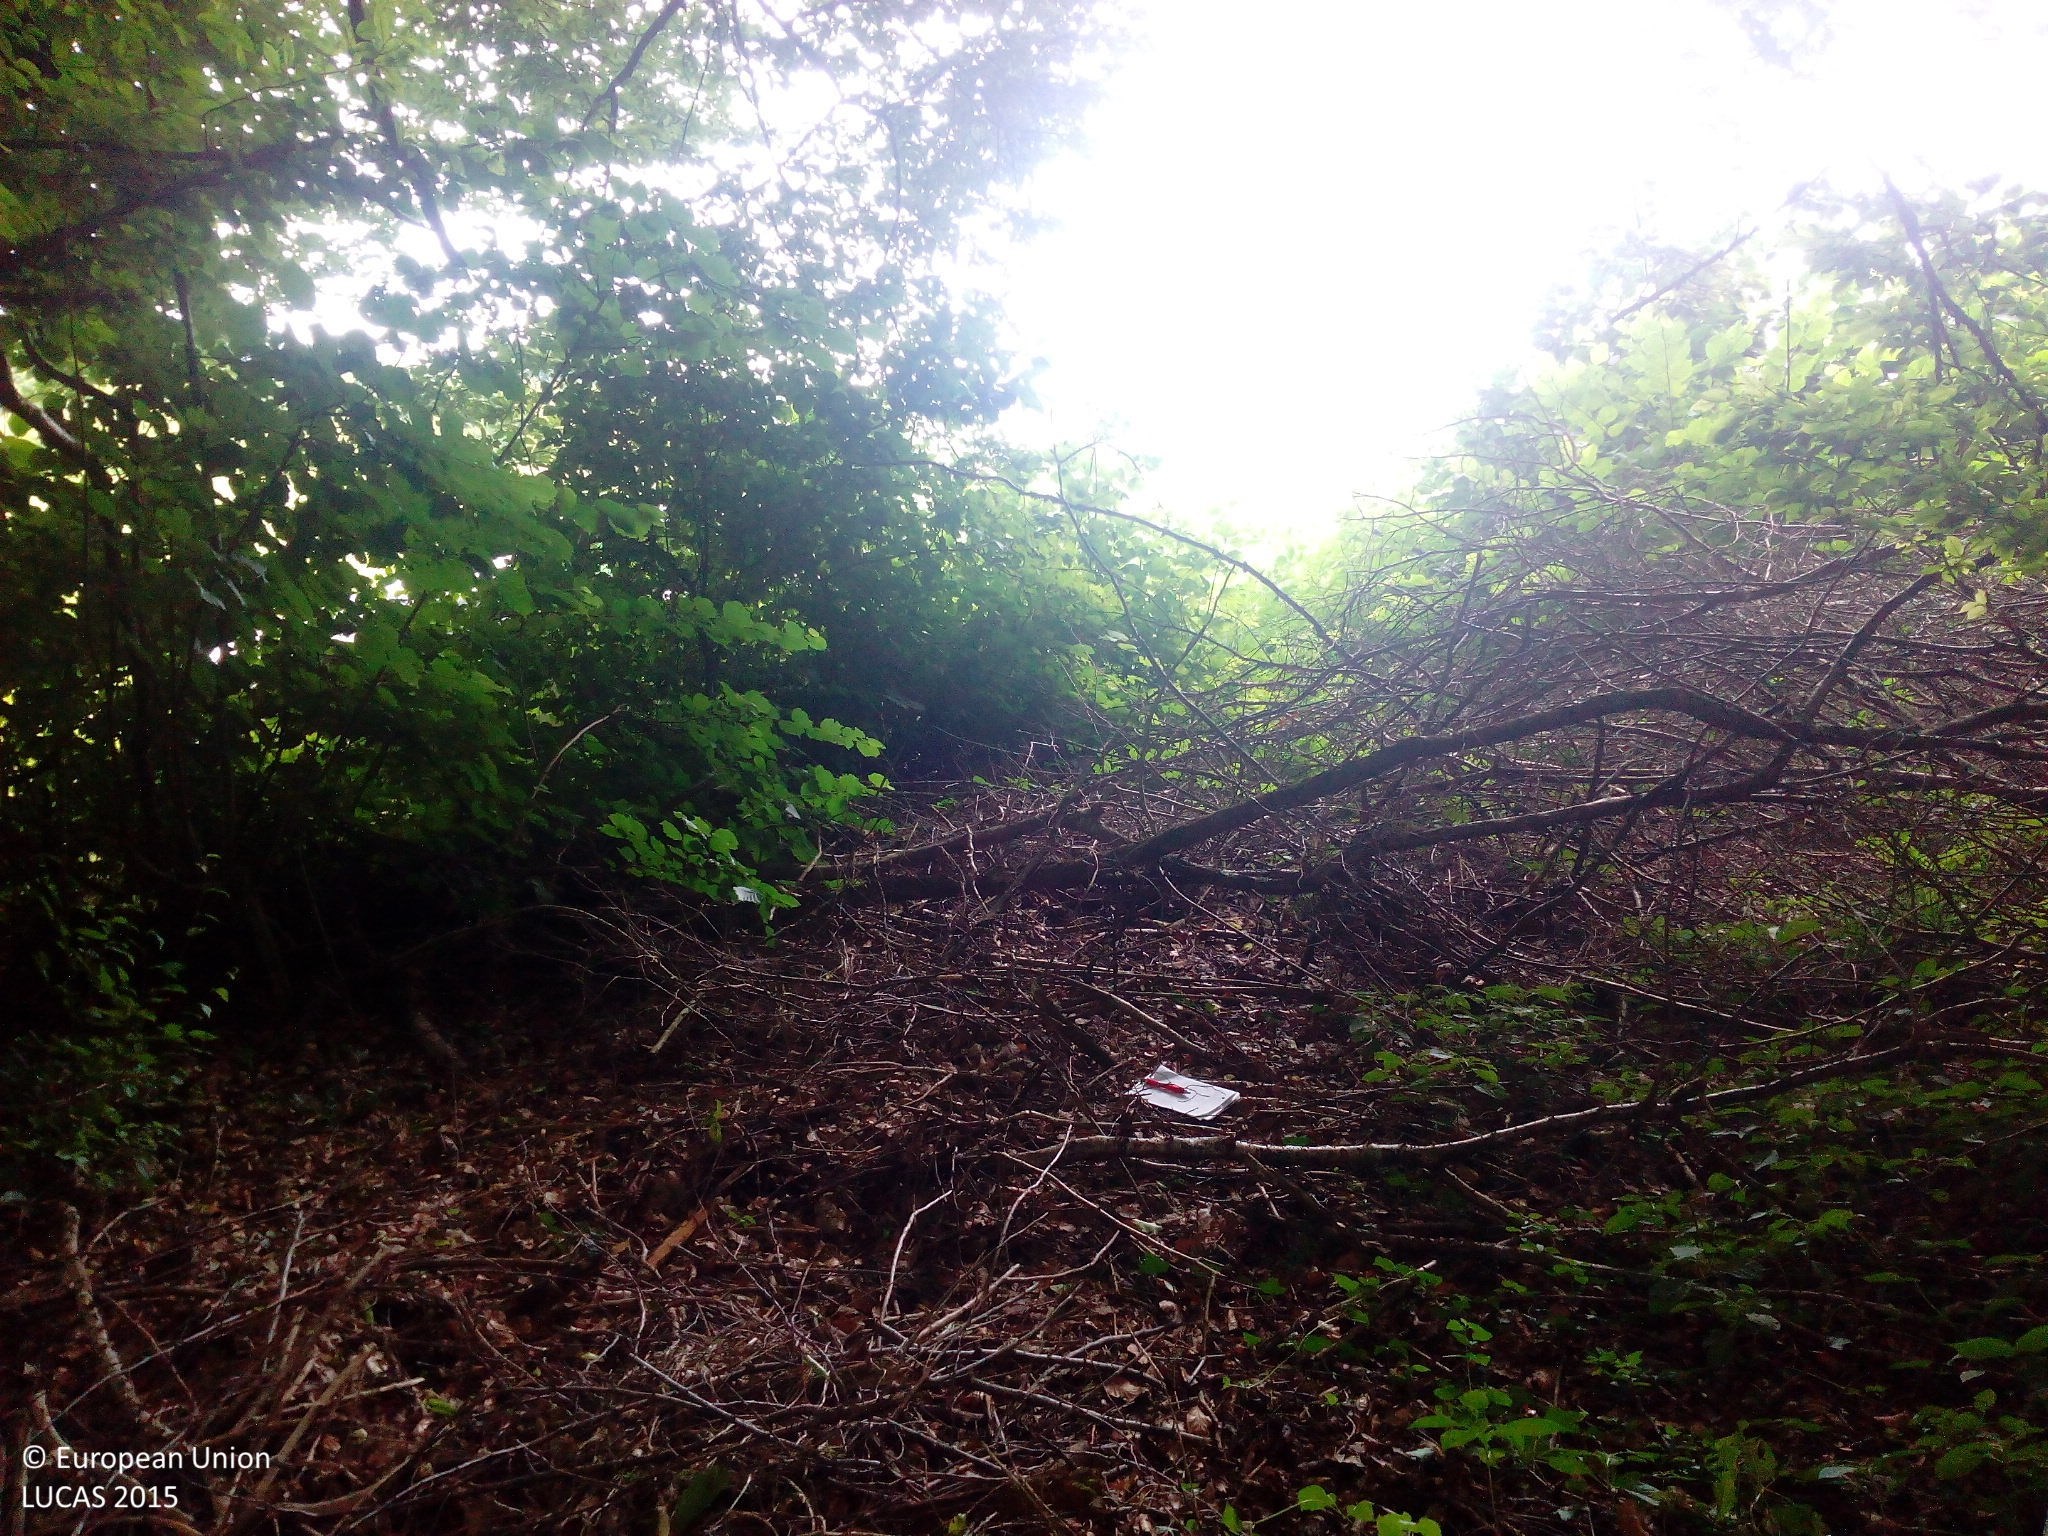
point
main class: Woodland
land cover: Broadleaved woodland
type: mesophytic deciduous forest
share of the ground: > 75 %
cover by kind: broadleaved forest trees 100 %
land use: Forestry
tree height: > 5 m
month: July
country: DE
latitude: 47.7177
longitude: 9.3473
